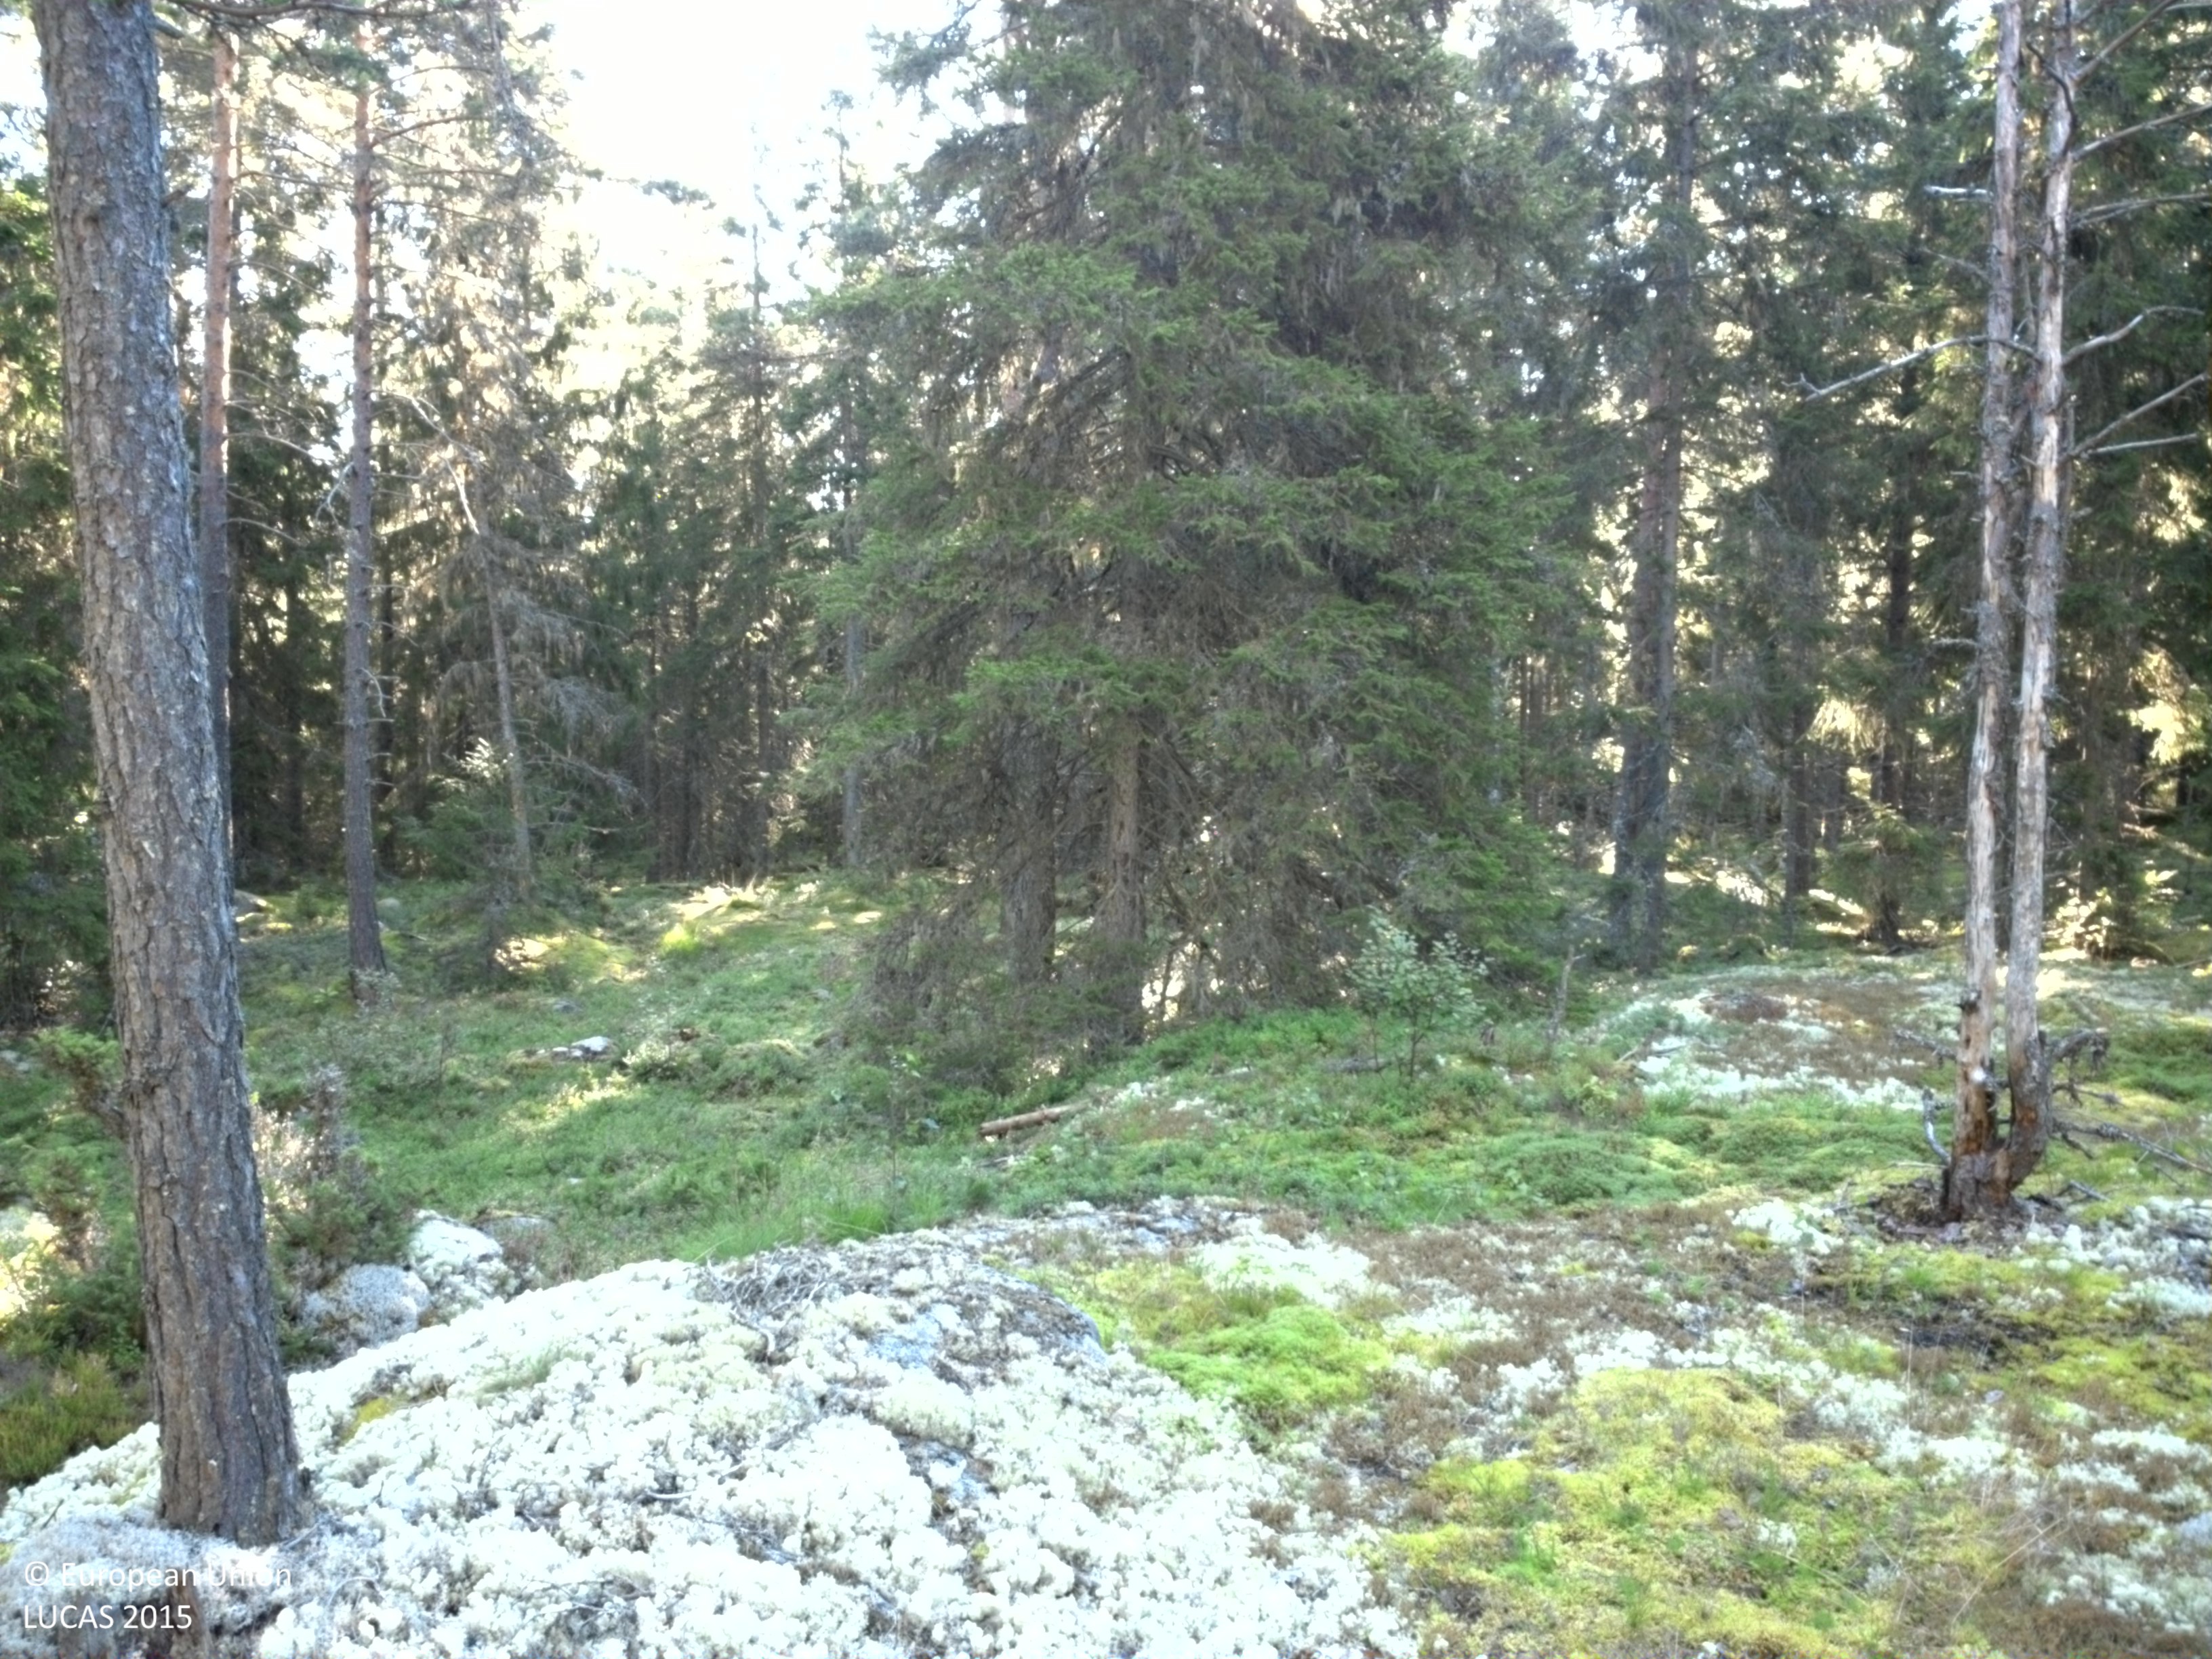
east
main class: Woodland
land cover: Pine dominated coniferous woodland
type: boreal forest
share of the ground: 50 - 75 %
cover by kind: coniferous forest trees 65 %, lichens and mosses 25 %, shrubs 10 %
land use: Forestry
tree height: > 5 m
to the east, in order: Pine dominated coniferous woodland; Spruce dominated coniferous woodland; Tracks; Grass margins; Spruce dominated coniferous woodland
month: August
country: SE
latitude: 59.7775
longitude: 17.2423
